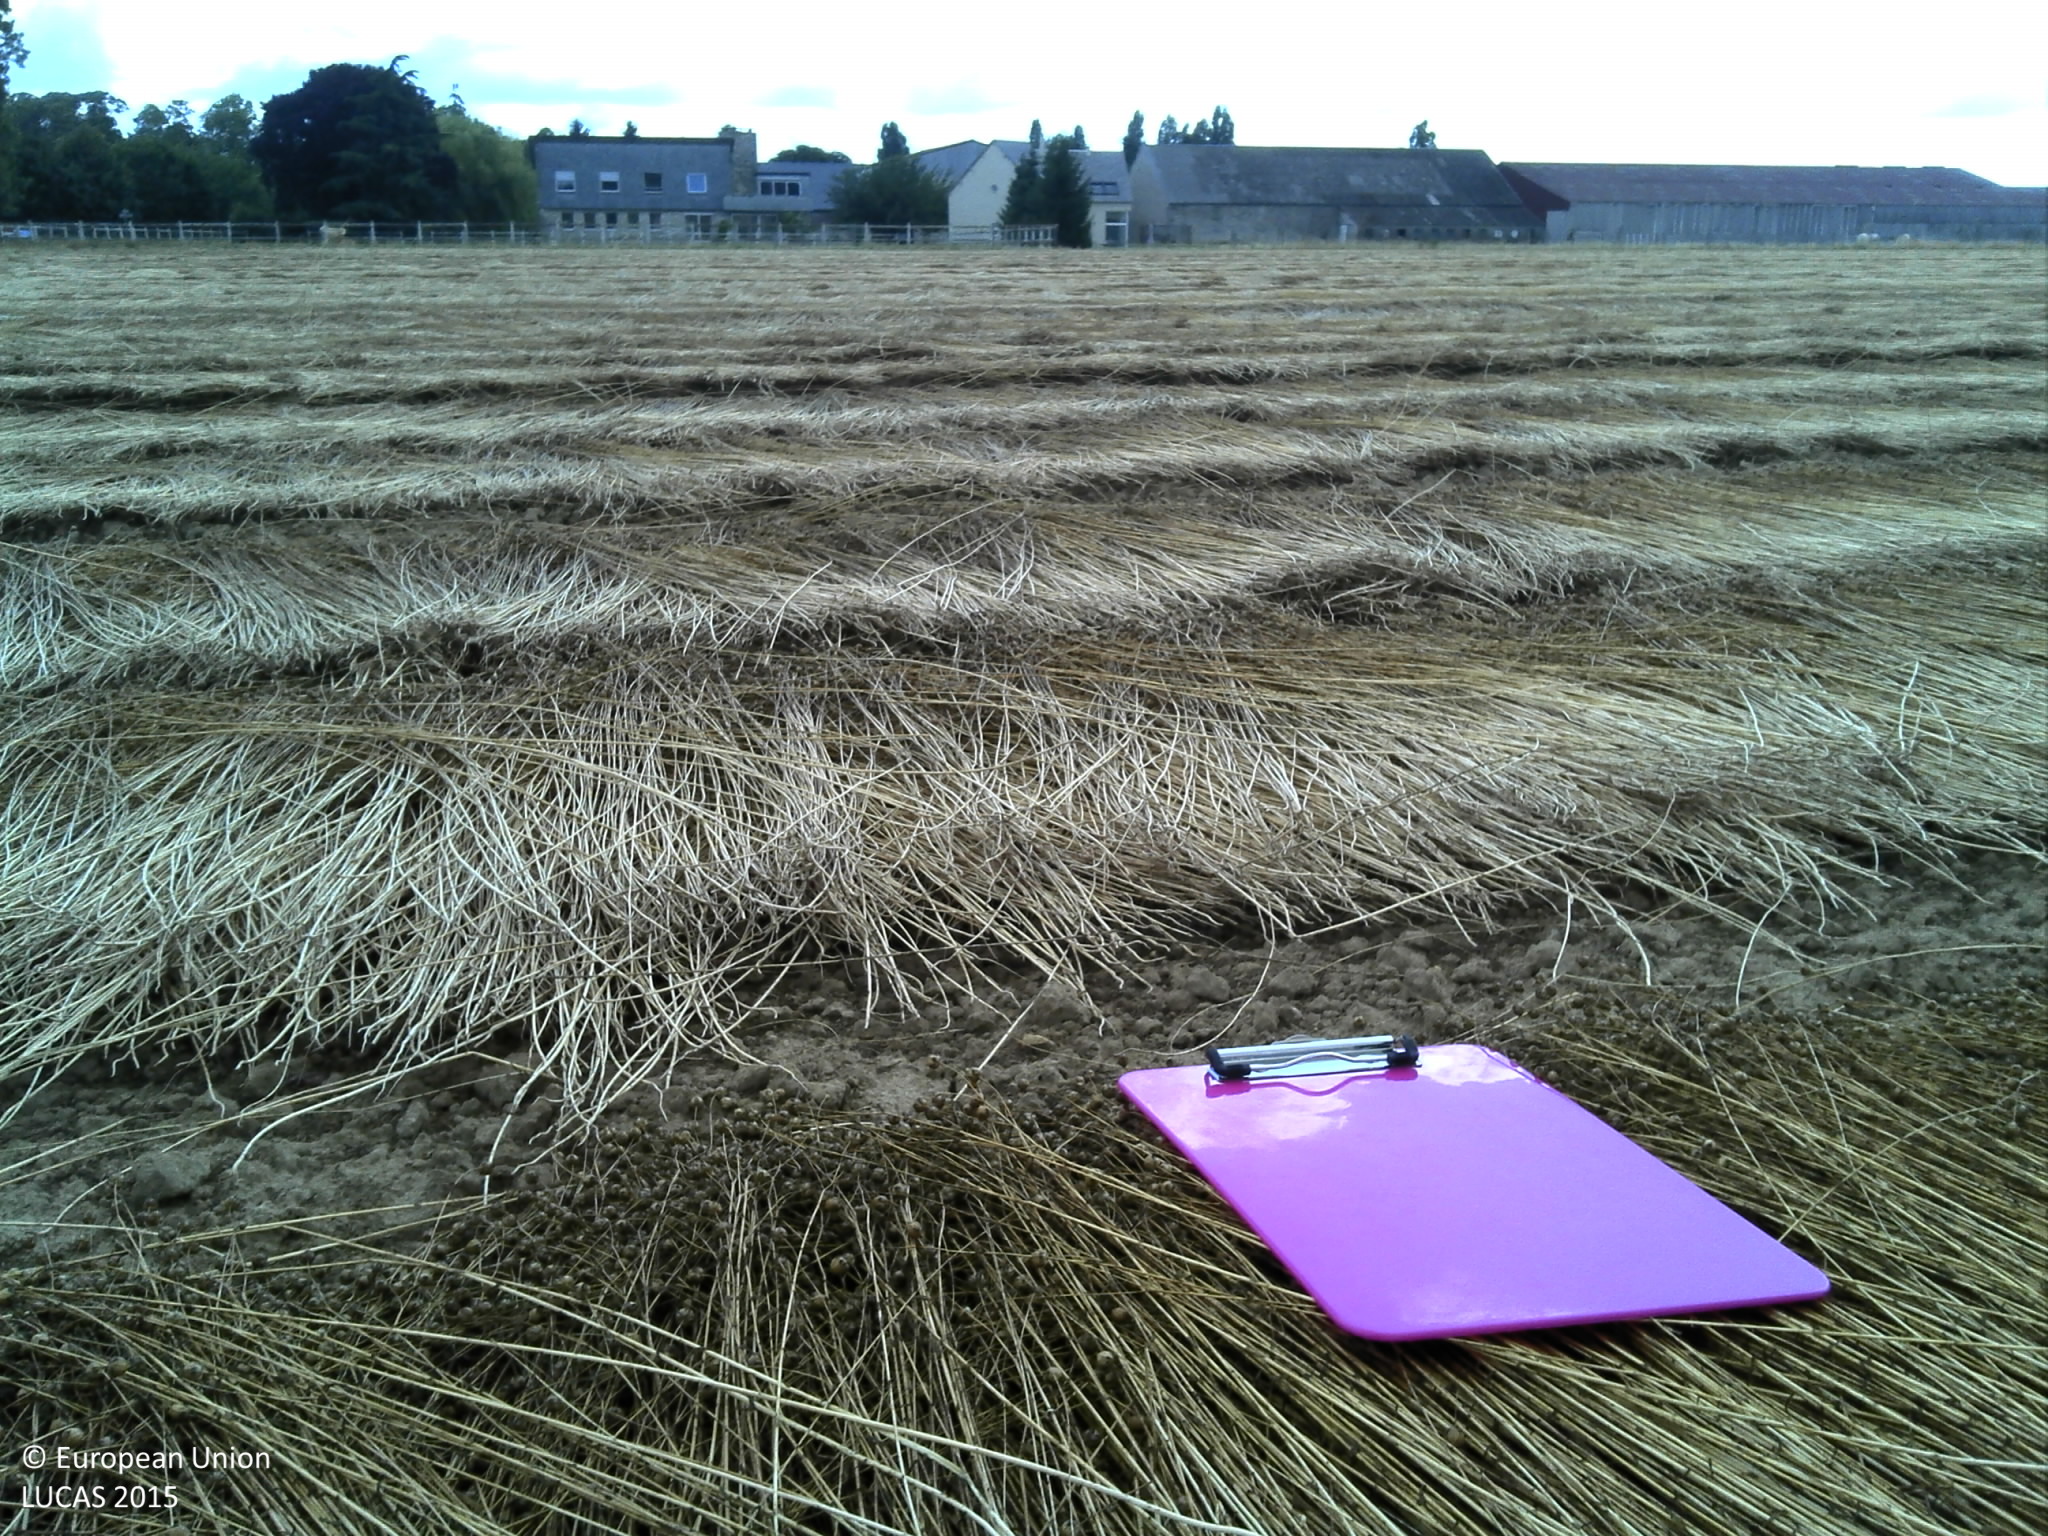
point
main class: Cropland
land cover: Other fibre and oleaginous crops
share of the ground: > 75 %
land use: Agriculture (excluding fallow land and kitchen gardens)
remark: Harvested field
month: July
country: FR
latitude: 48.8774
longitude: 1.8170
